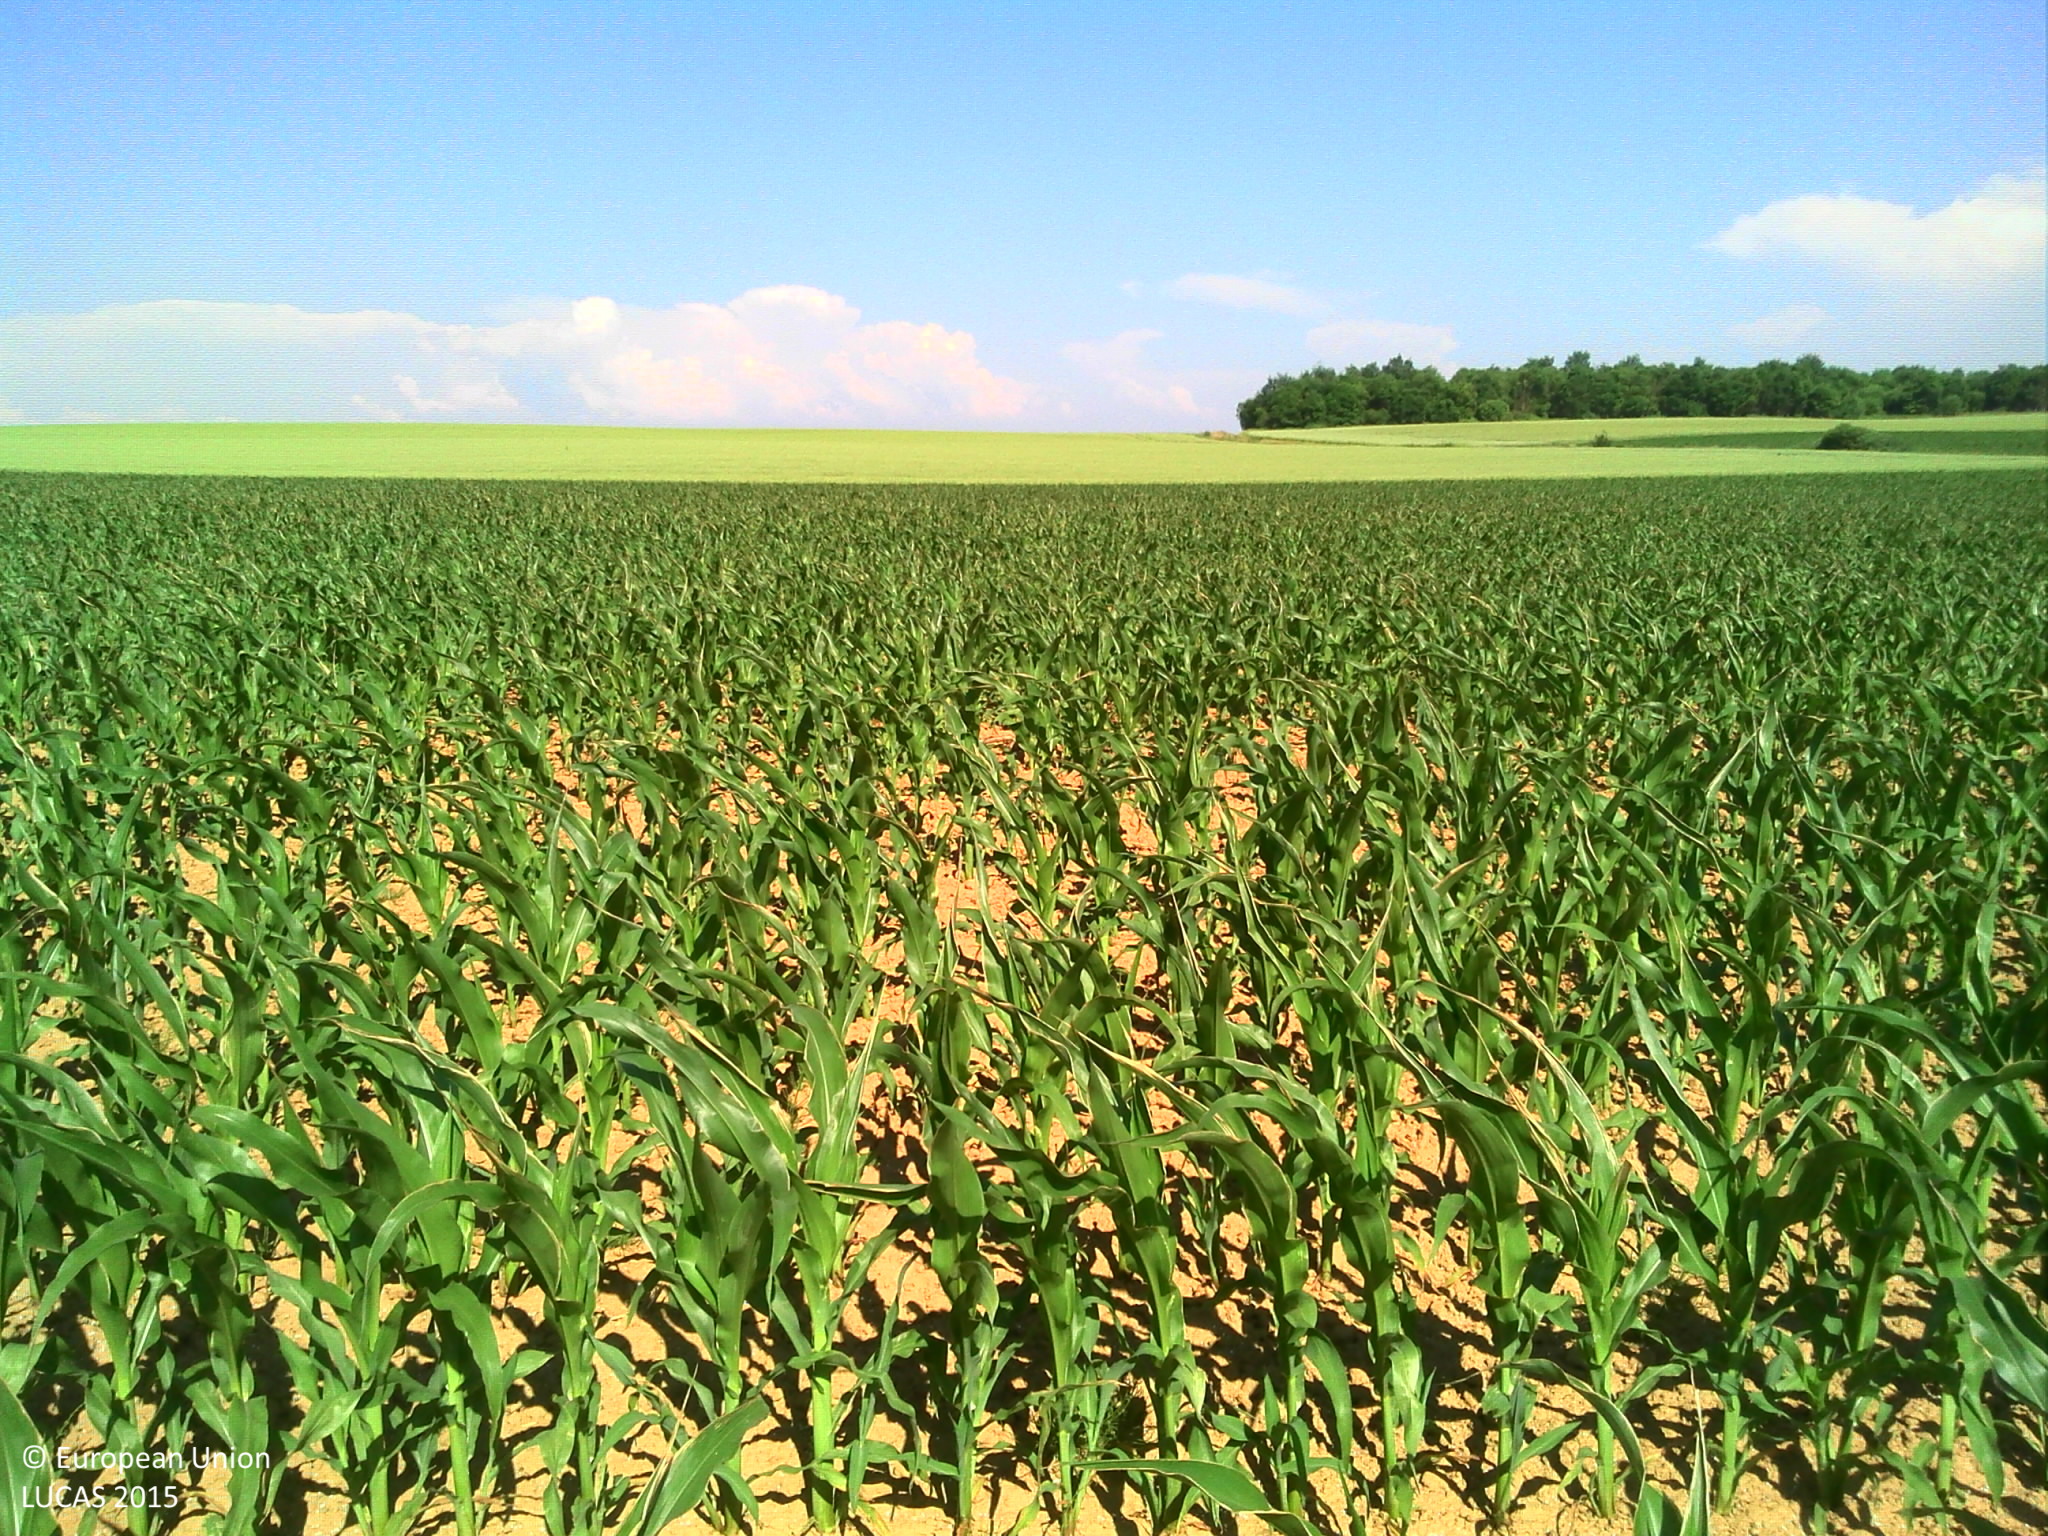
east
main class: Cropland
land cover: Maize
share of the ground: 50 - 75 %
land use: Agriculture (excluding fallow land and kitchen gardens)
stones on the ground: 10 - 25 %
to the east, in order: Maize; Grass margins; Common wheat
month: June
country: FR
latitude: 45.9734
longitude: 4.8276
